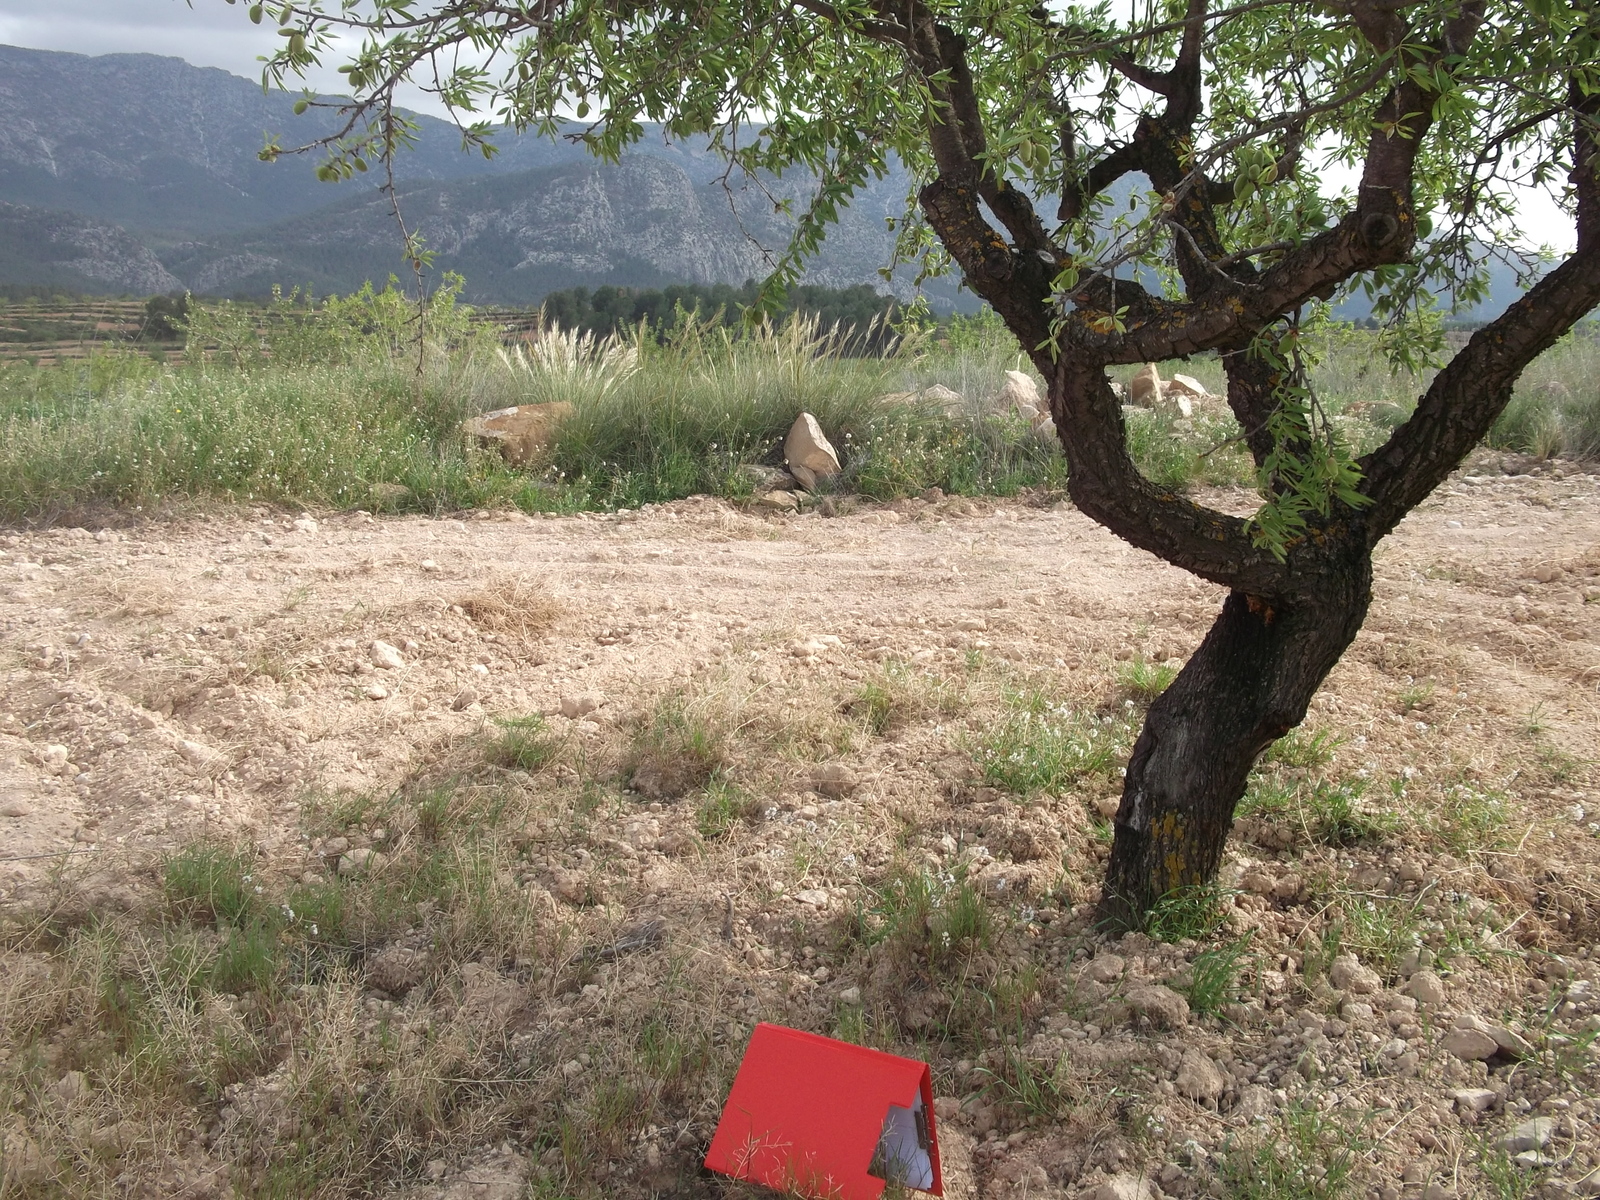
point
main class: Cropland
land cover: Nuts trees
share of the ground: < 10 %
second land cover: Spontaneously vegetated surfaces
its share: > 75 %
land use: Agriculture (excluding fallow land and kitchen gardens)
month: April
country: ES
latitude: 37.9522
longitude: -1.5824
